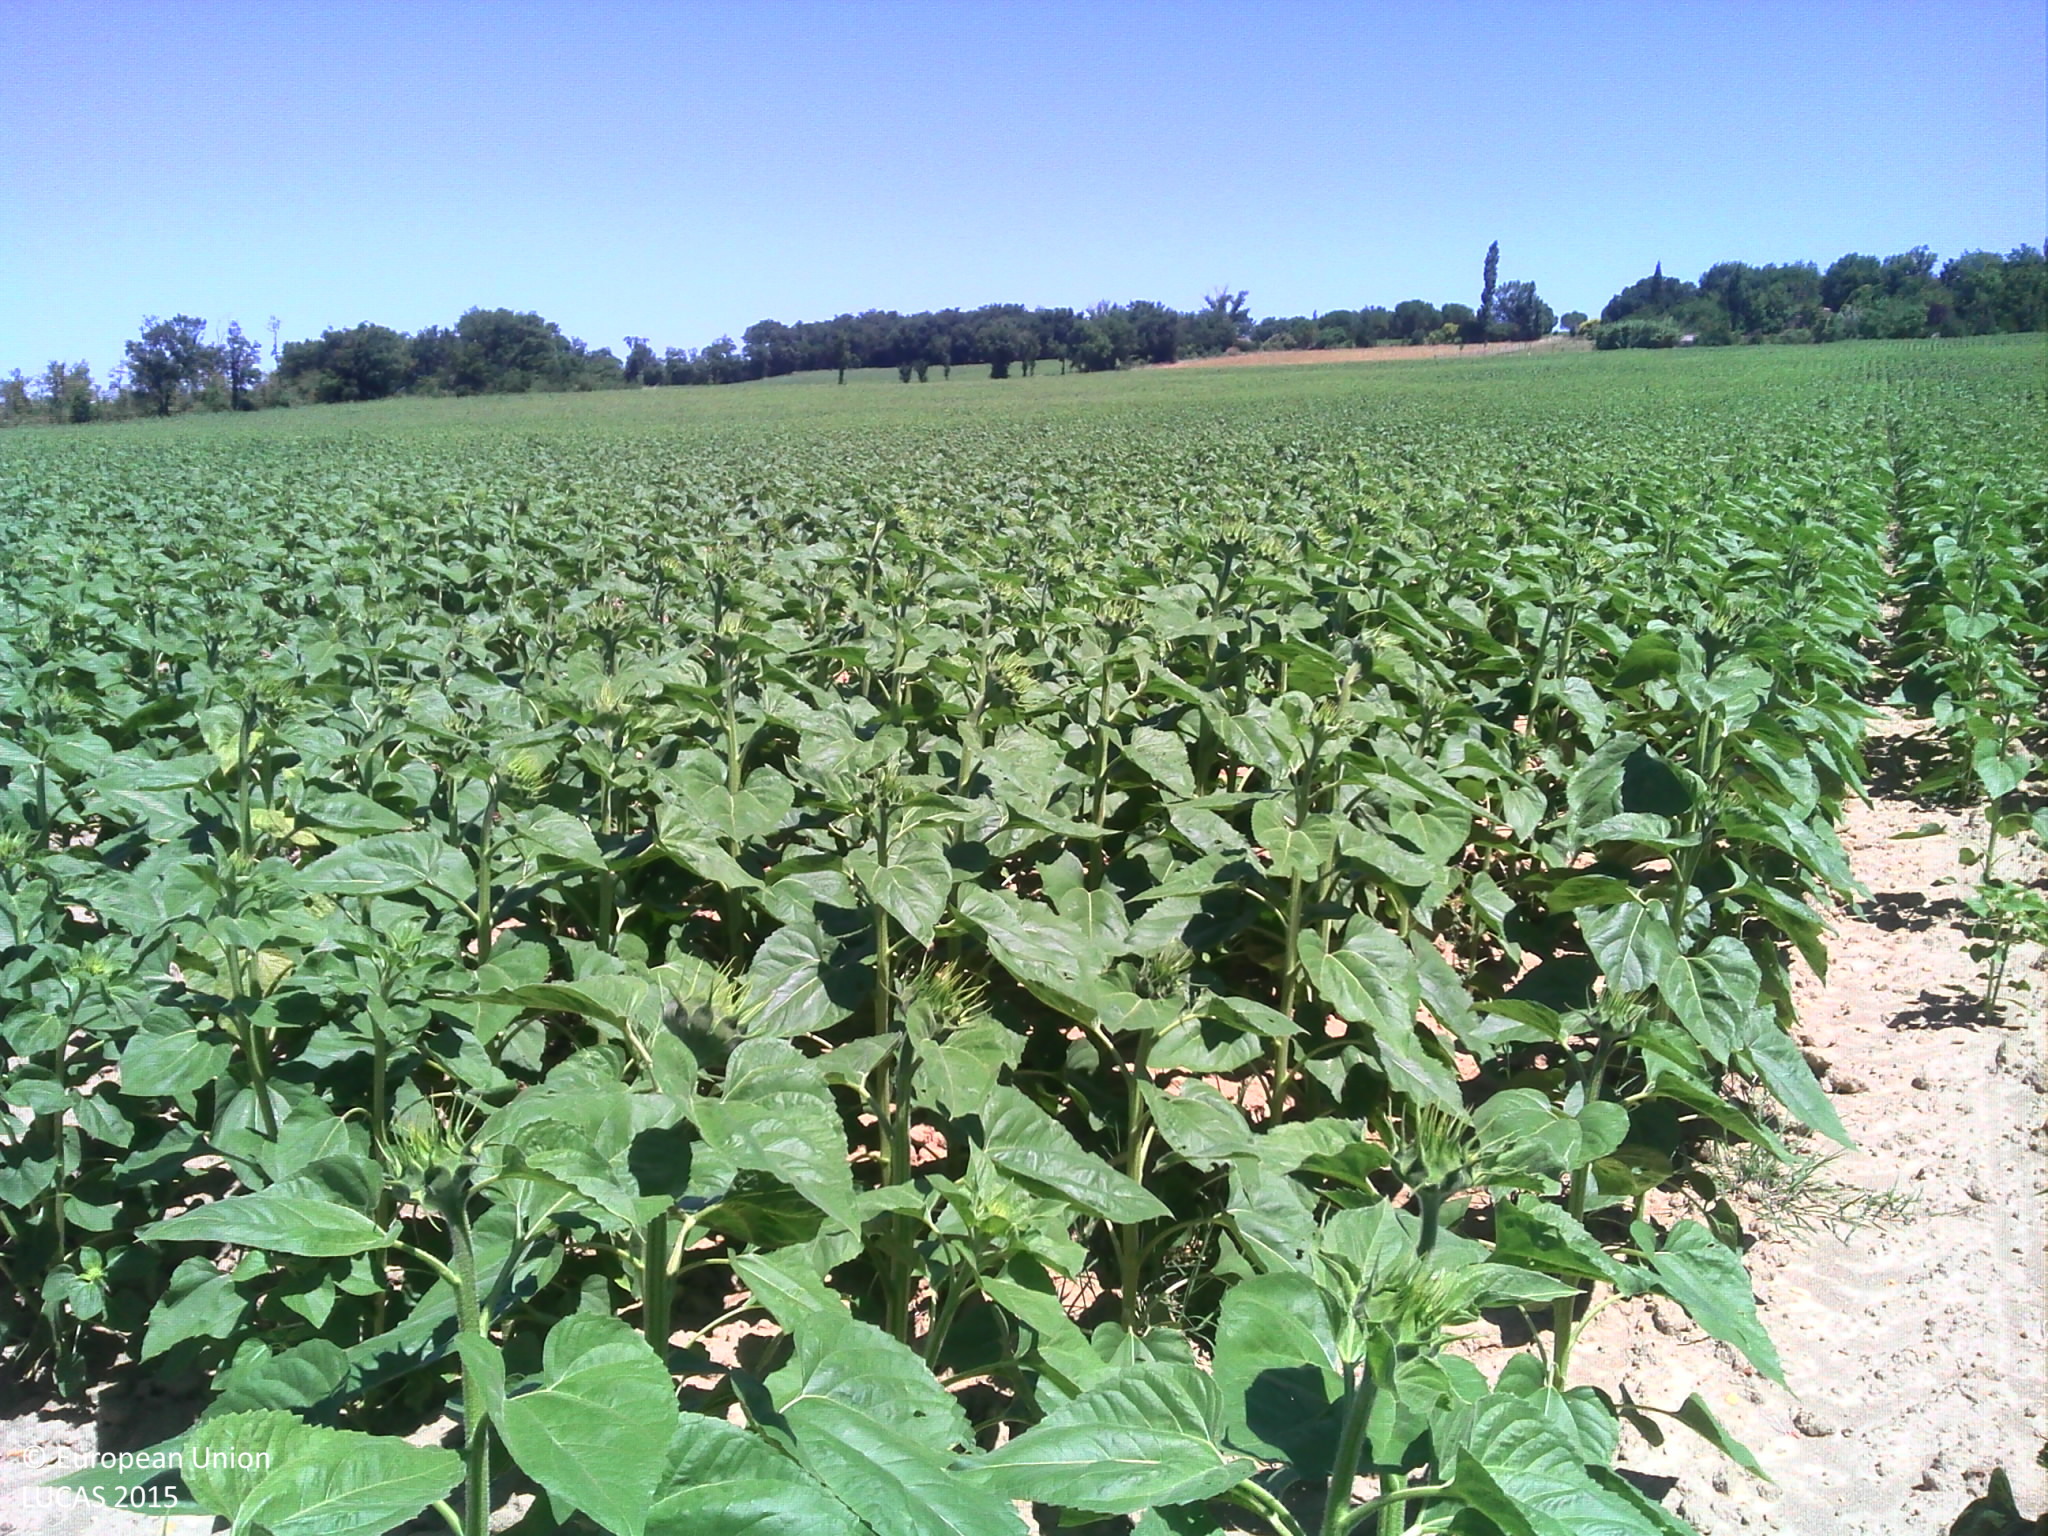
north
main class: Cropland
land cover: Sunflower
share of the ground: 50 - 75 %
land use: Agriculture (excluding fallow land and kitchen gardens)
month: June
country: FR
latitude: 43.3187
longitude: 2.0286
